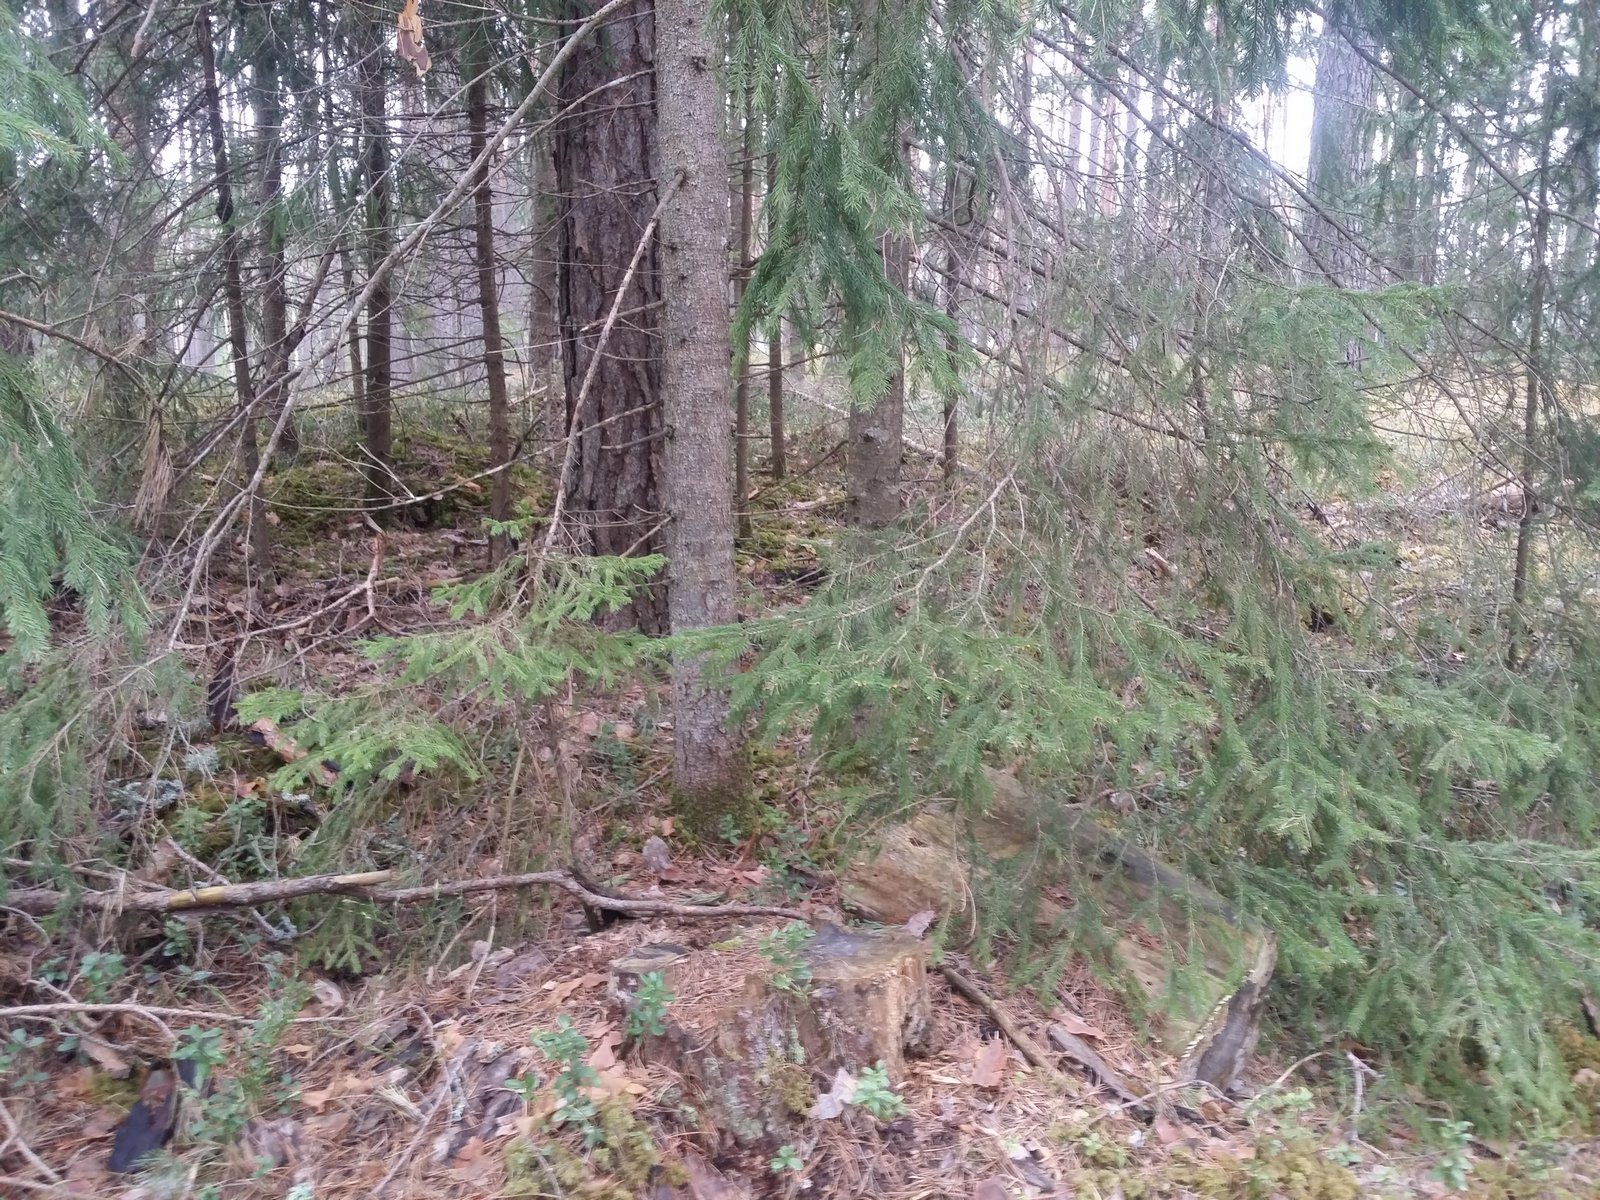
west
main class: Woodland
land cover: Other coniferous woodland
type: hemiboreal forest and nemoral coniferous forest and mixed broadleaved-coniferous forest
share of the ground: > 75 %
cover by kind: coniferous forest trees 90 %, lichens and mosses 10 %
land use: Forestry
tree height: > 5 m
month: May
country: LV
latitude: 57.4483
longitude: 26.0436
